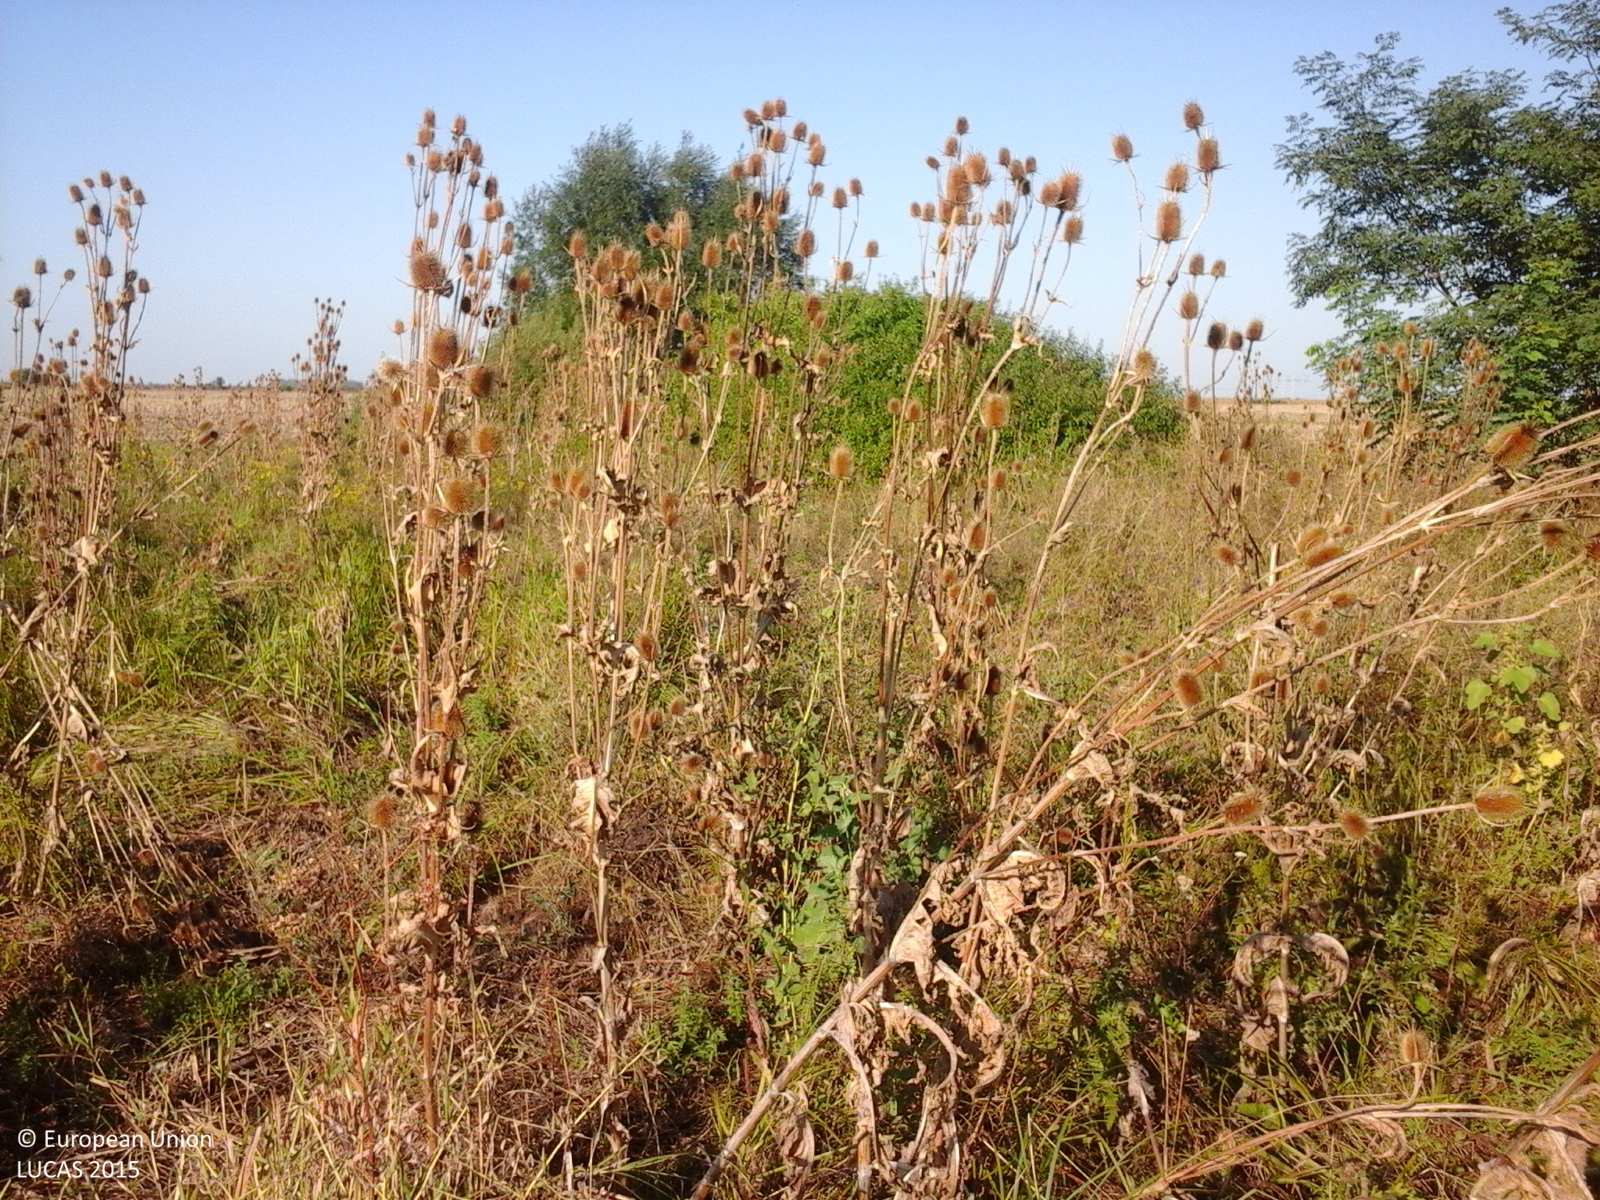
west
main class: Grassland
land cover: Spontaneously vegetated surfaces
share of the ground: > 75 %
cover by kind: herbaceous plants 100 %
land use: Fallow land
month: September
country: RO
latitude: 47.5607
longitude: 22.8348
